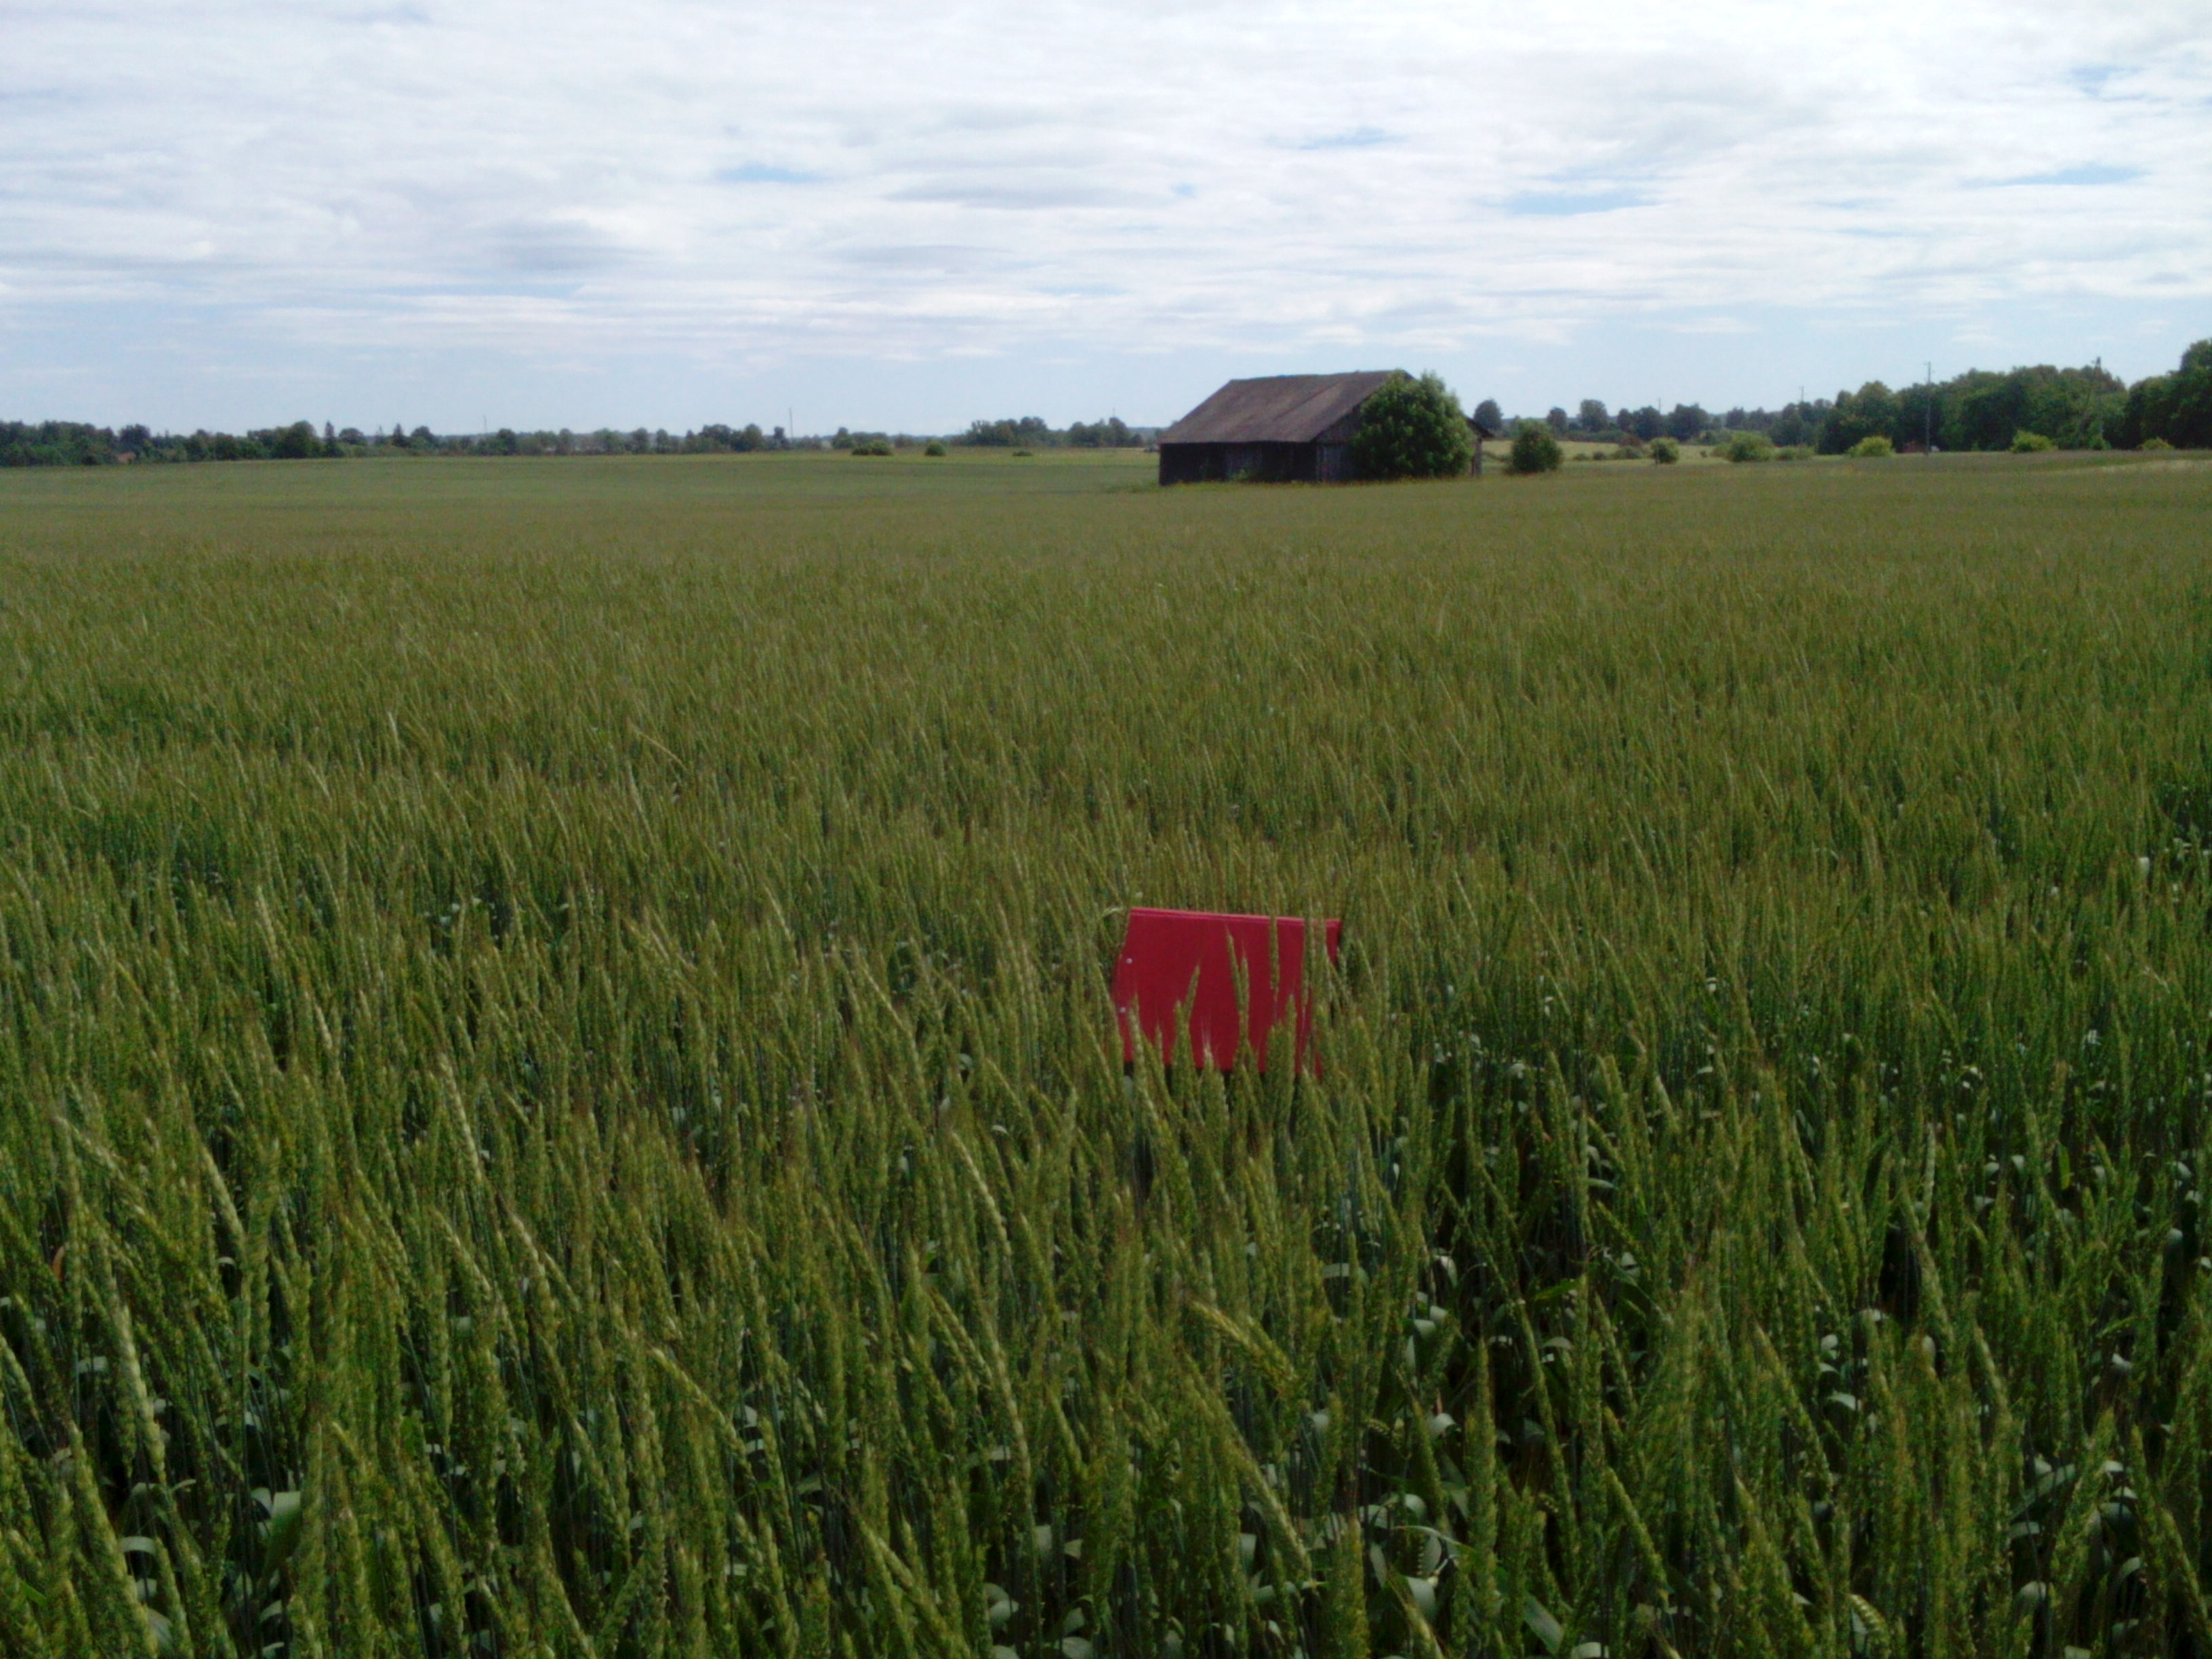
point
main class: Cropland
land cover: Common wheat
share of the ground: > 75 %
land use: Agriculture (excluding fallow land and kitchen gardens)
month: July
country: LV
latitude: 56.4612
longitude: 22.1751
